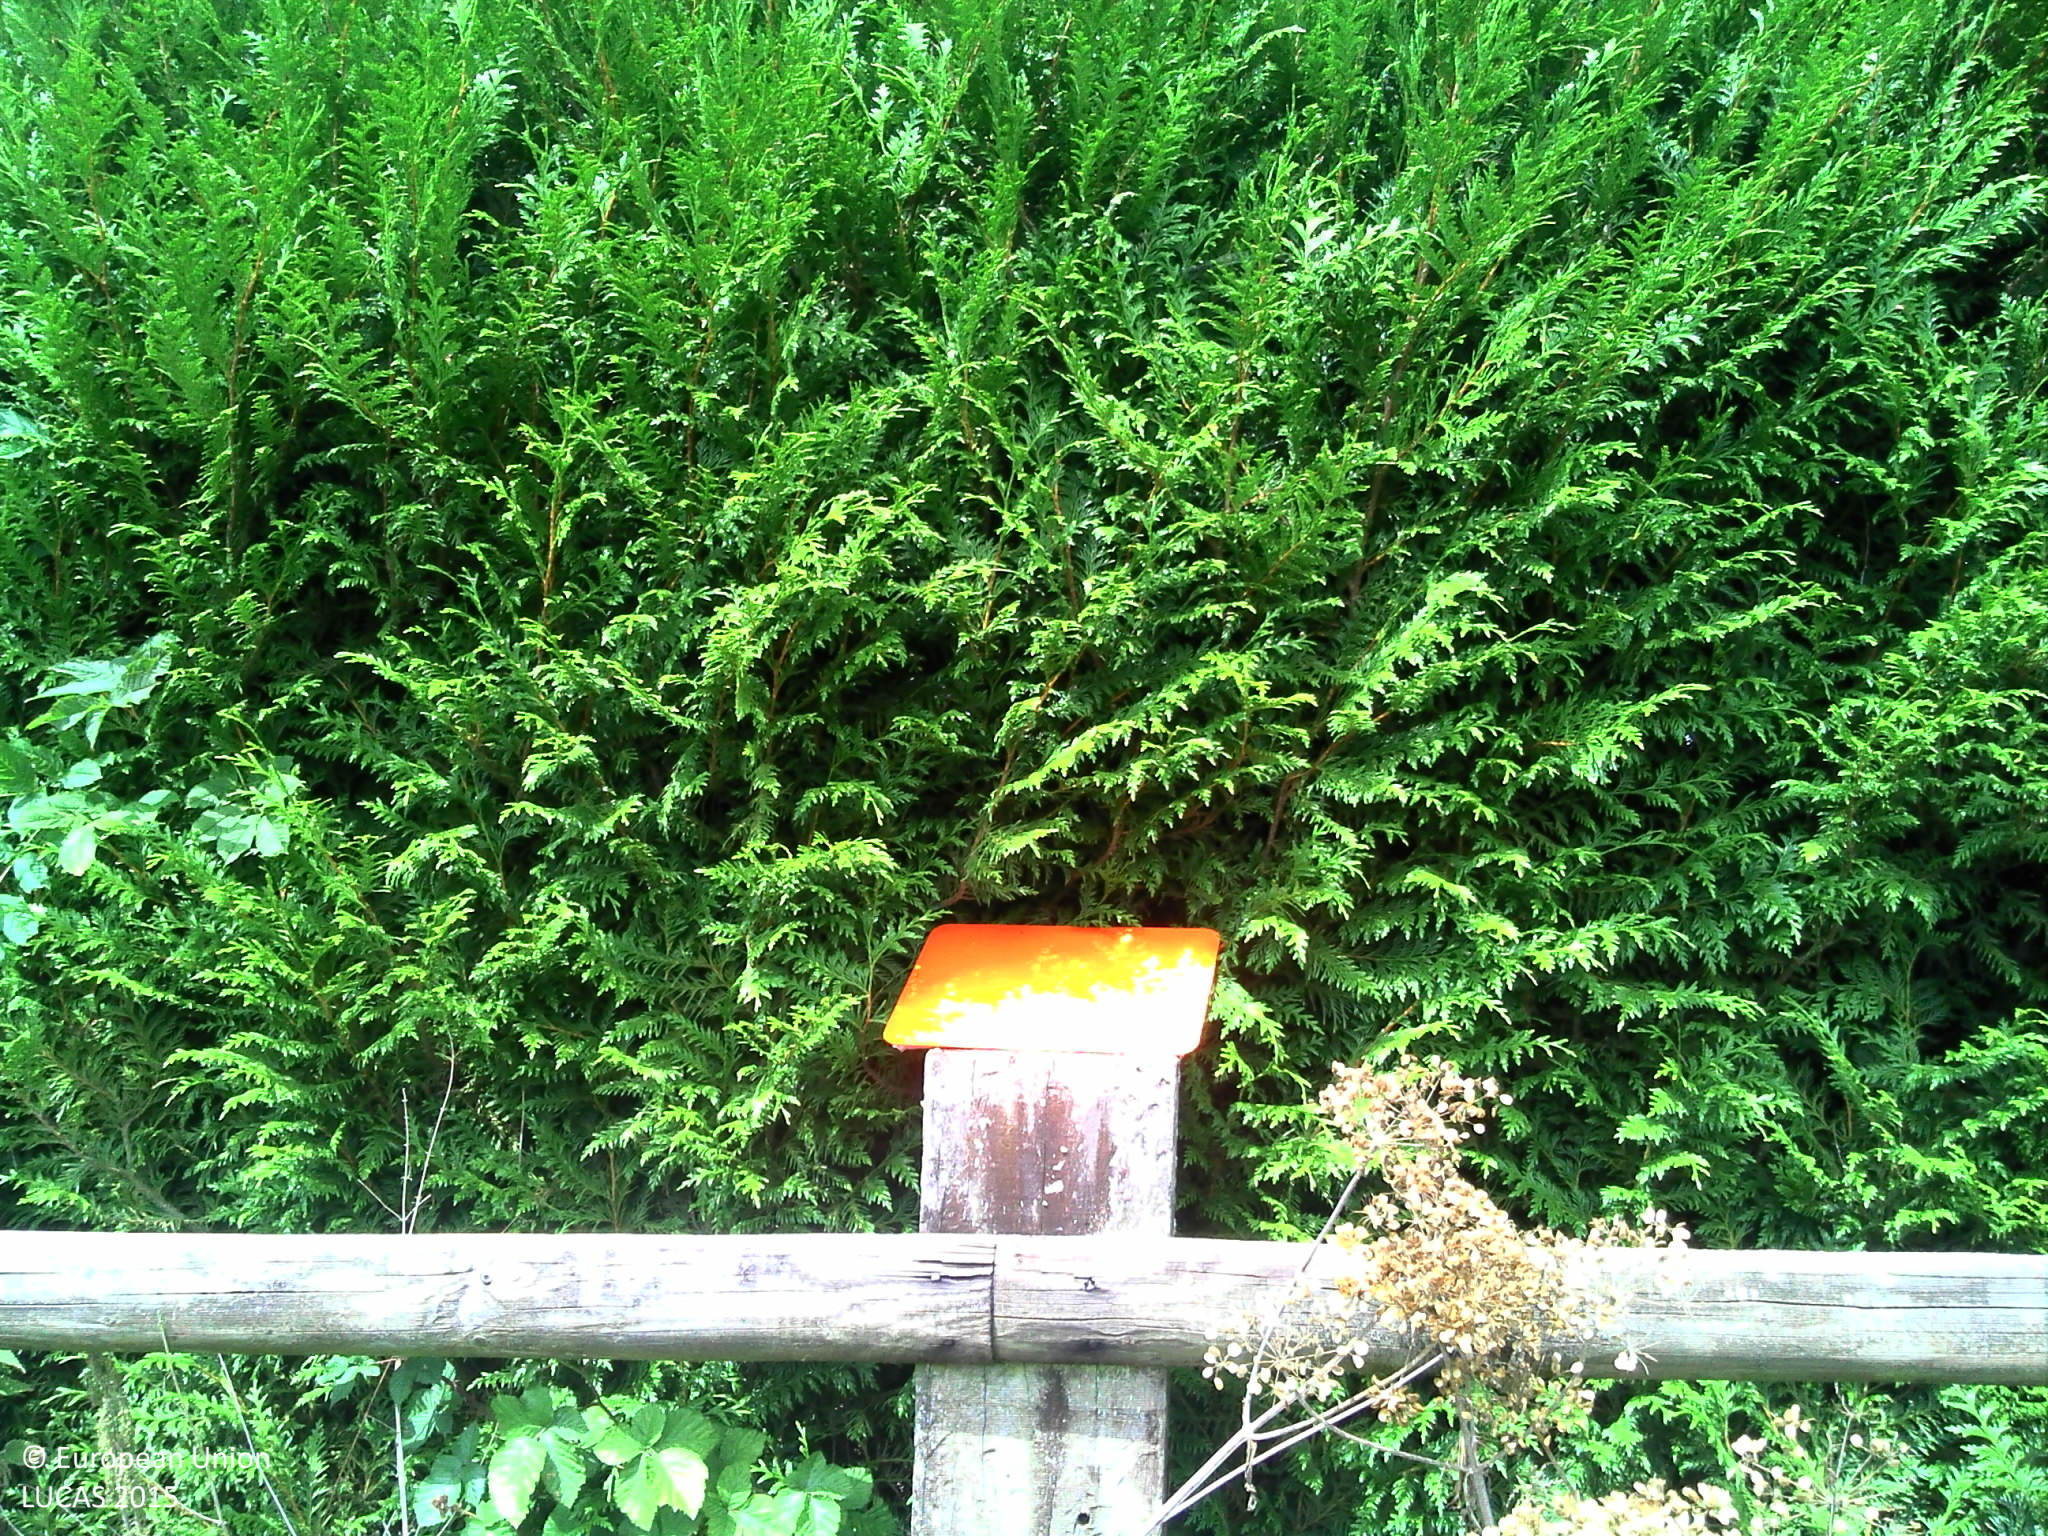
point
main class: Grassland
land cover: Grassland without tree/shrub cover
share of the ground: > 75 %
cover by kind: herbaceous plants 100 %
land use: Residential
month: July
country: FR
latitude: 48.6246
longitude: 0.4641
